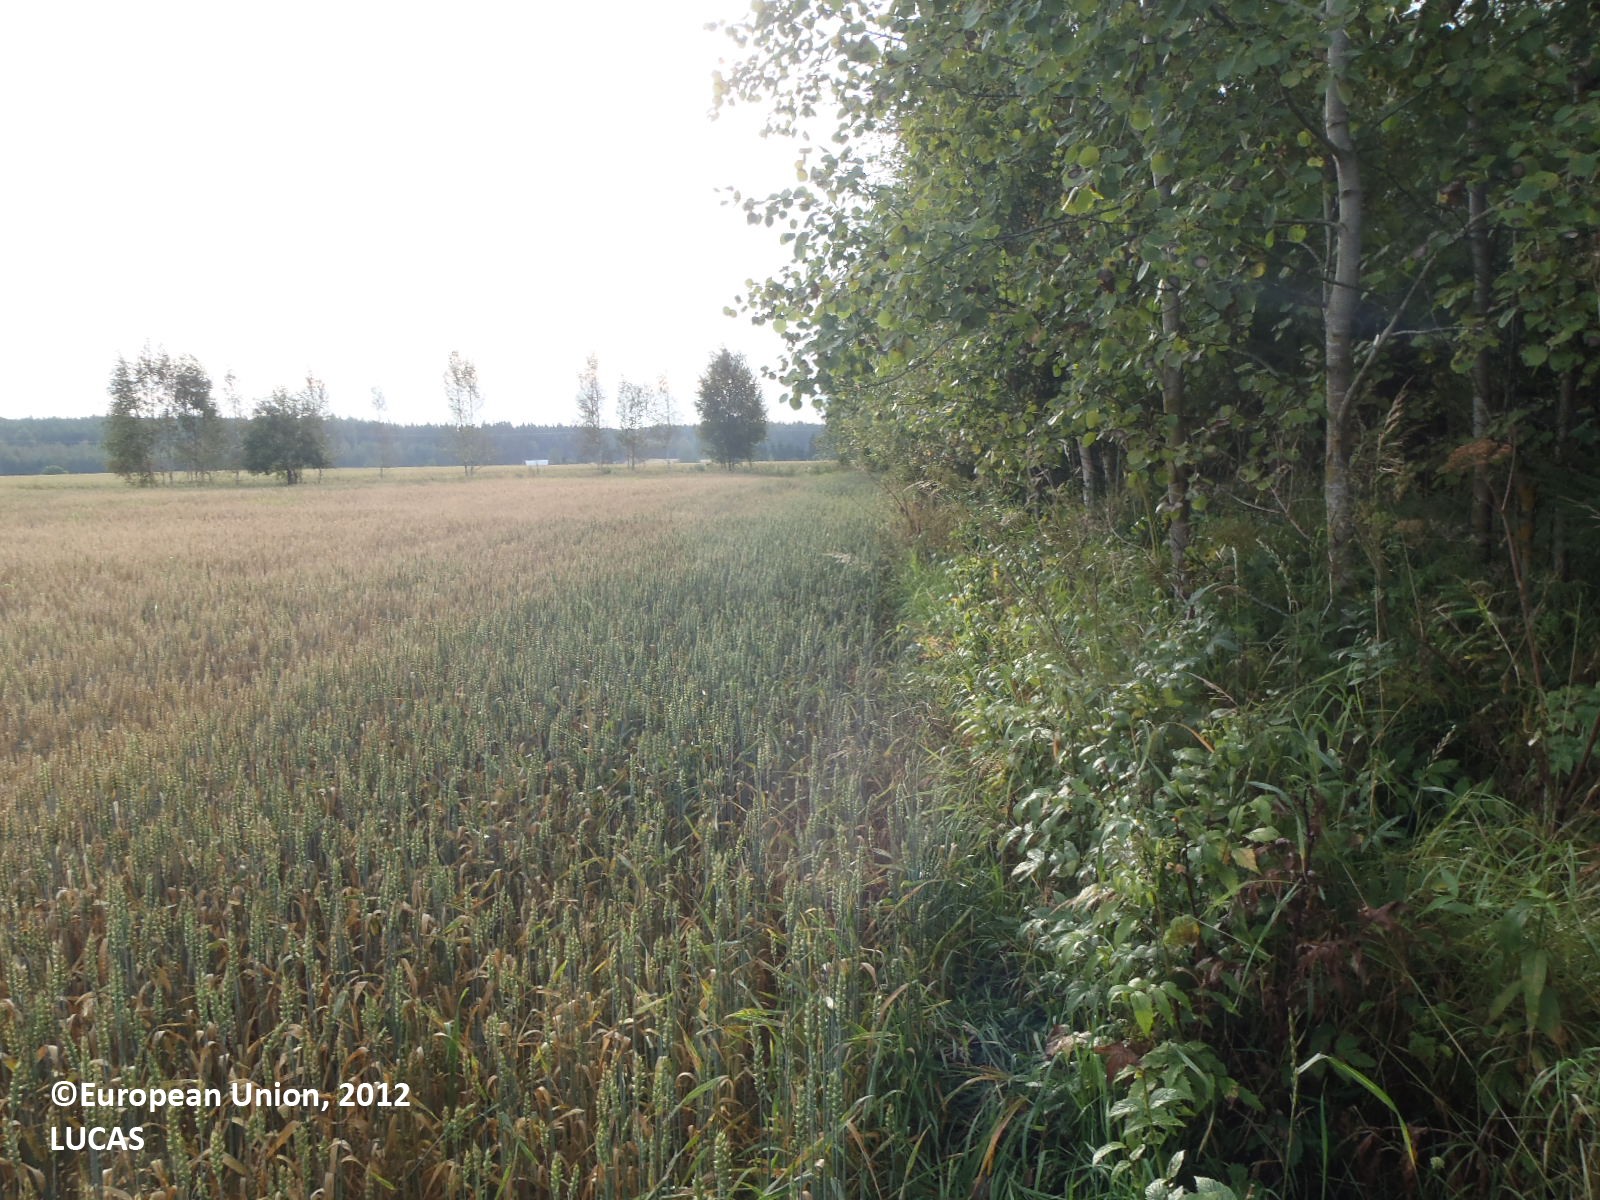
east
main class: Cropland
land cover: Common wheat
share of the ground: > 75 %
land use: Agriculture (excluding fallow land and kitchen gardens)
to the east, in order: Common wheat; Grass margins; Ditches and canals; Grass margins; Common wheat
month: September
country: FI
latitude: 60.8130
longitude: 22.6630
